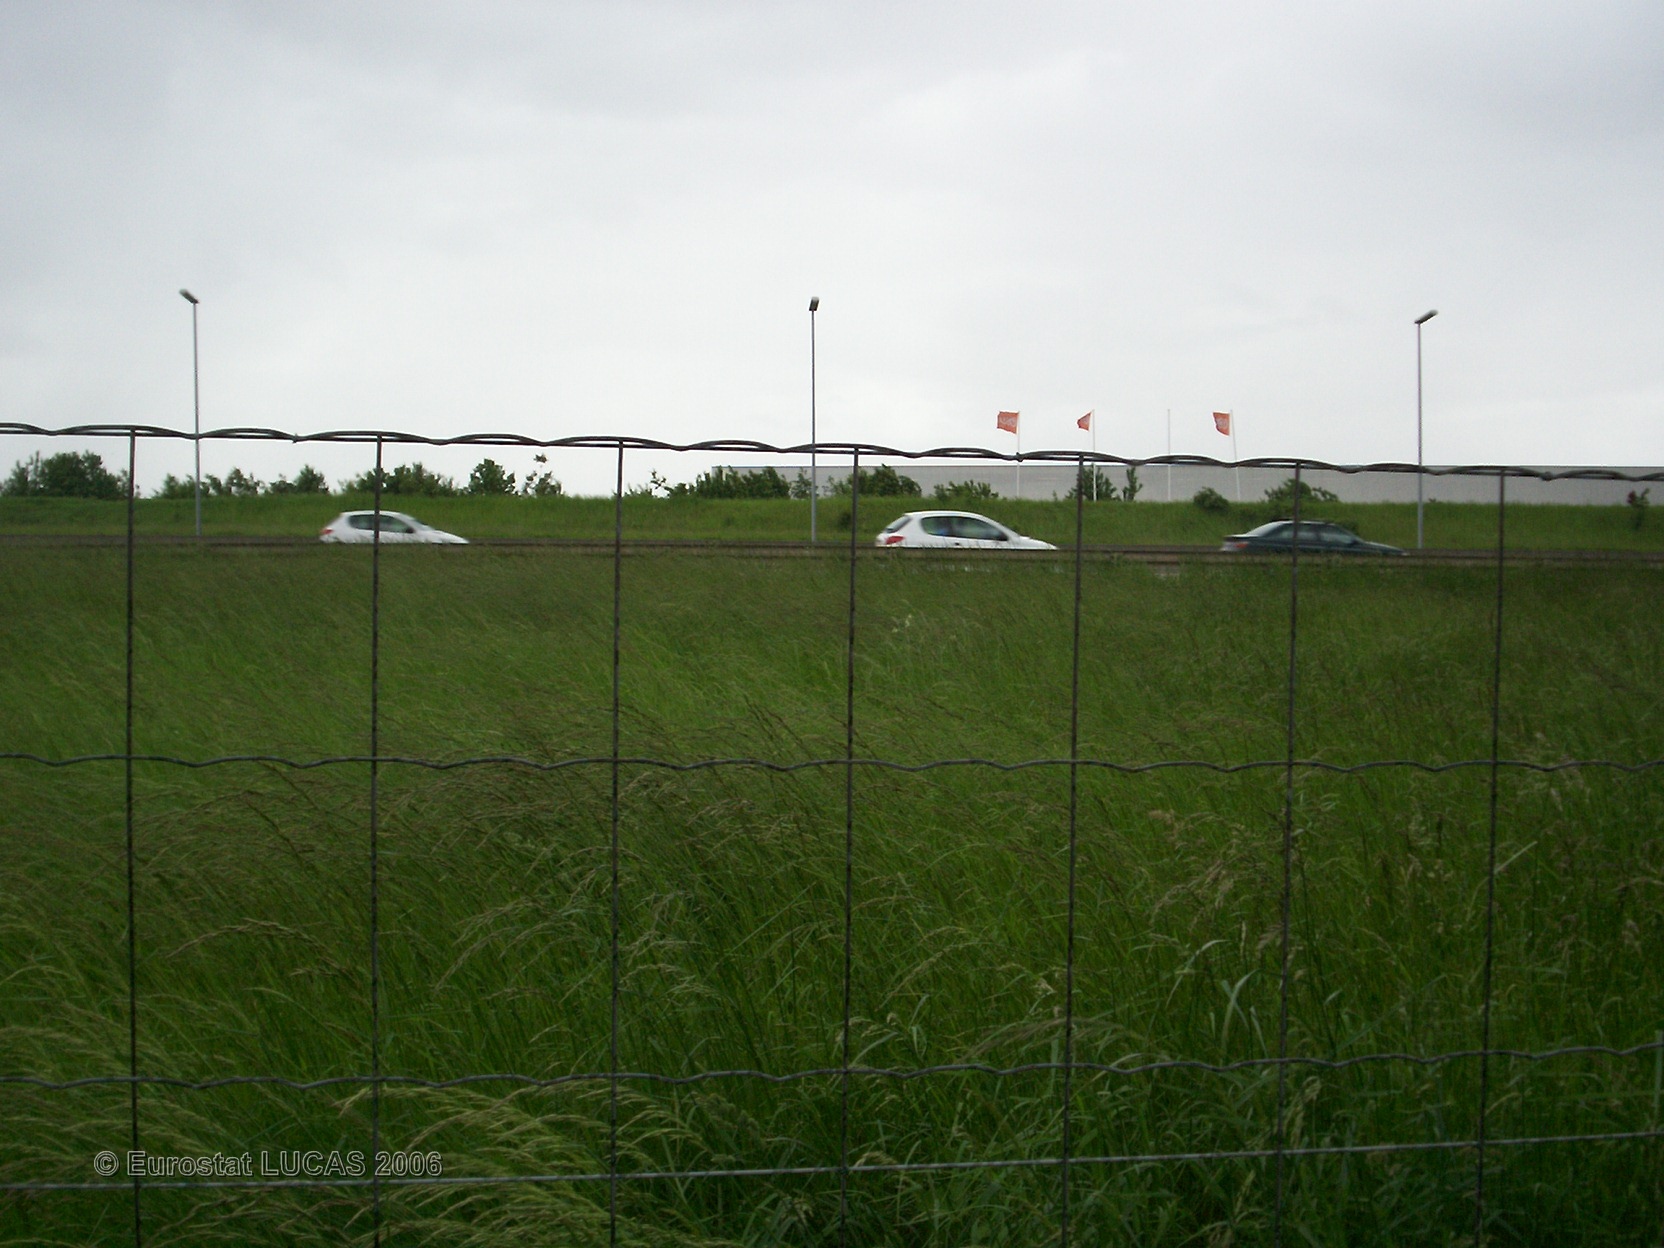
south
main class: Grassland
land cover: Grassland without tree/shrub cover
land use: Road transport
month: May
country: FR
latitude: 48.8305
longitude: 2.7018
